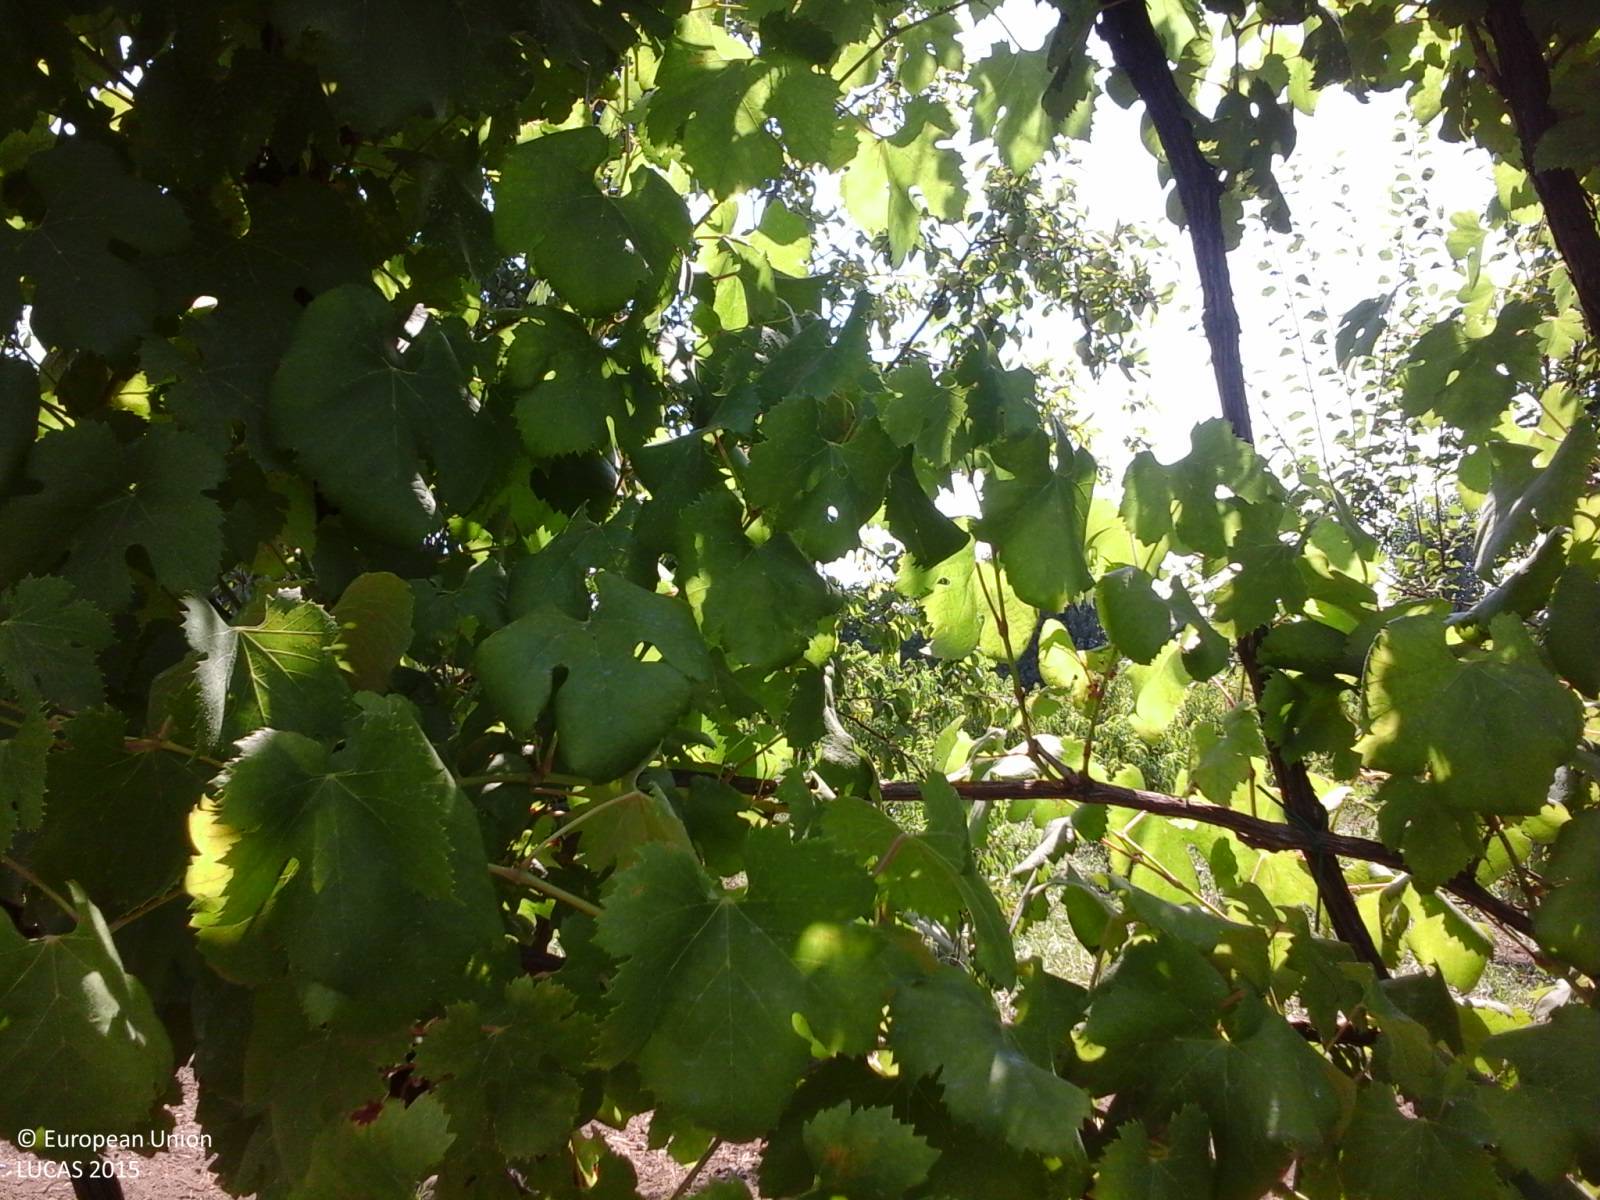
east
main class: Cropland
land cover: Vineyards
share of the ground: 50 - 75 %
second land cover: Other bare soil
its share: > 75 %
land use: Agriculture (excluding fallow land and kitchen gardens)
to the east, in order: Vineyards; Other bare soil; Other fruit trees and berries; Lines of trees; Spontaneously vegetated surfaces; Grass margins; Fences; Lines of trees; Nurseries; Fences; Lines of trees; Spontaneously vegetated surfaces; Other fresh vegetables; Fences; Grassland without tree/shrub cover; Artificial constructions in urban areas
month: July
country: IT
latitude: 41.0106
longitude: 14.2040
